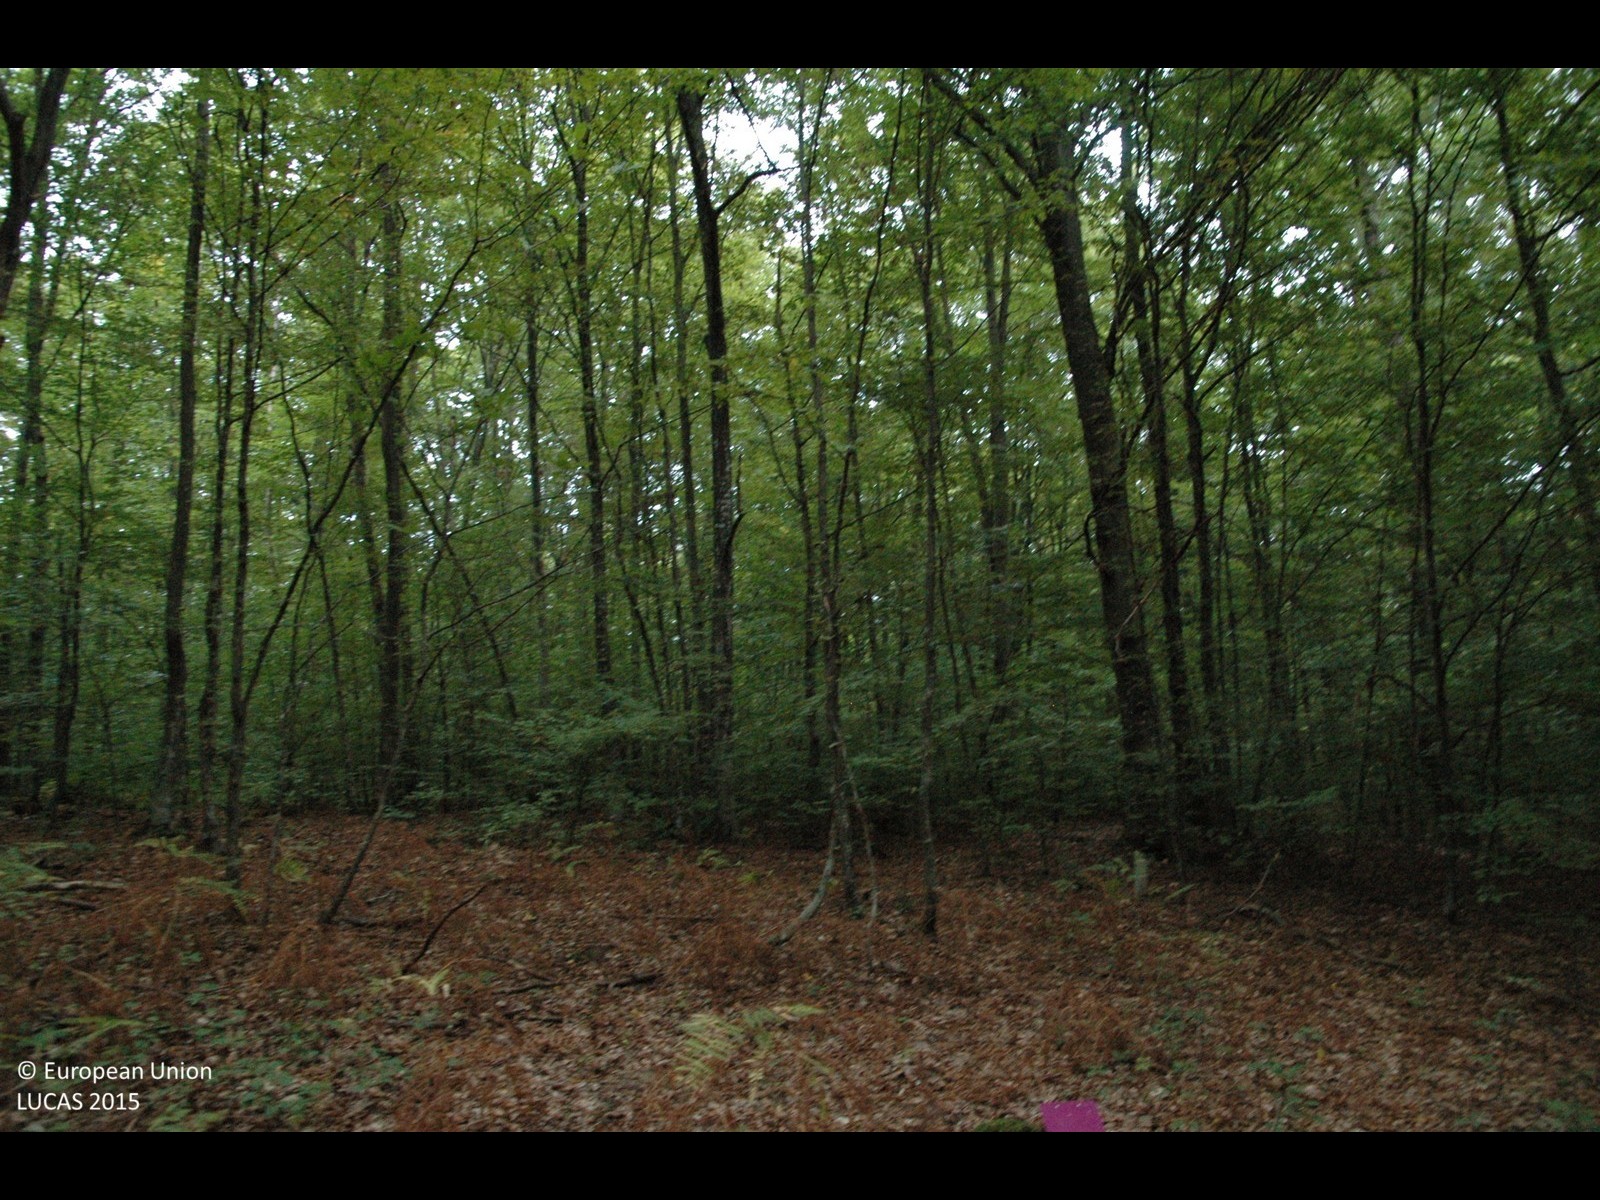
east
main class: Woodland
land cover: Broadleaved woodland
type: mesophytic deciduous forest
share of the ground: > 75 %
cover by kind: broadleaved forest trees 100 %
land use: Forestry
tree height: > 5 m
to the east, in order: Broadleaved woodland
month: October
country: HR
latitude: 45.5804
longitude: 16.1107
